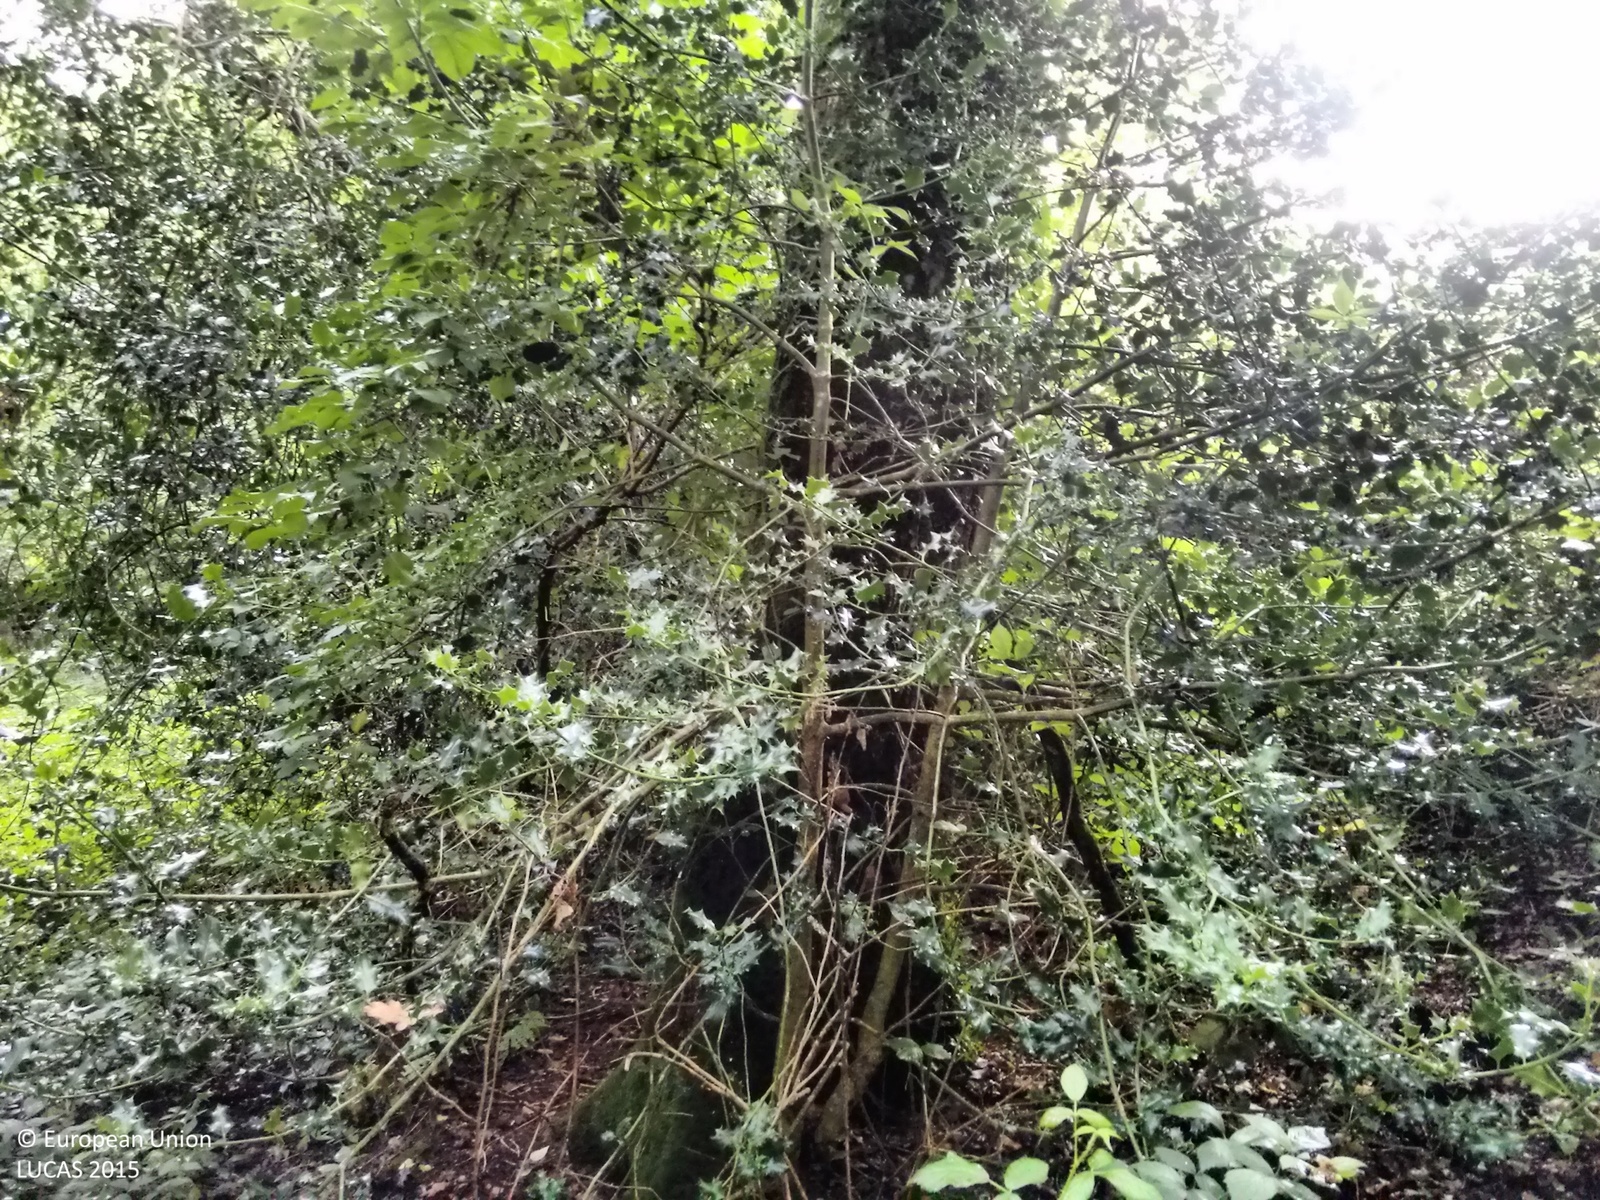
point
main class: Woodland
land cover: Broadleaved woodland
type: mesophytic deciduous forest
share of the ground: > 75 %
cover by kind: broadleaved forest trees 100 %
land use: Semi-natural and natural areas not in use
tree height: > 5 m
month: September
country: GB
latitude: 50.6769
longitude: -4.3518
